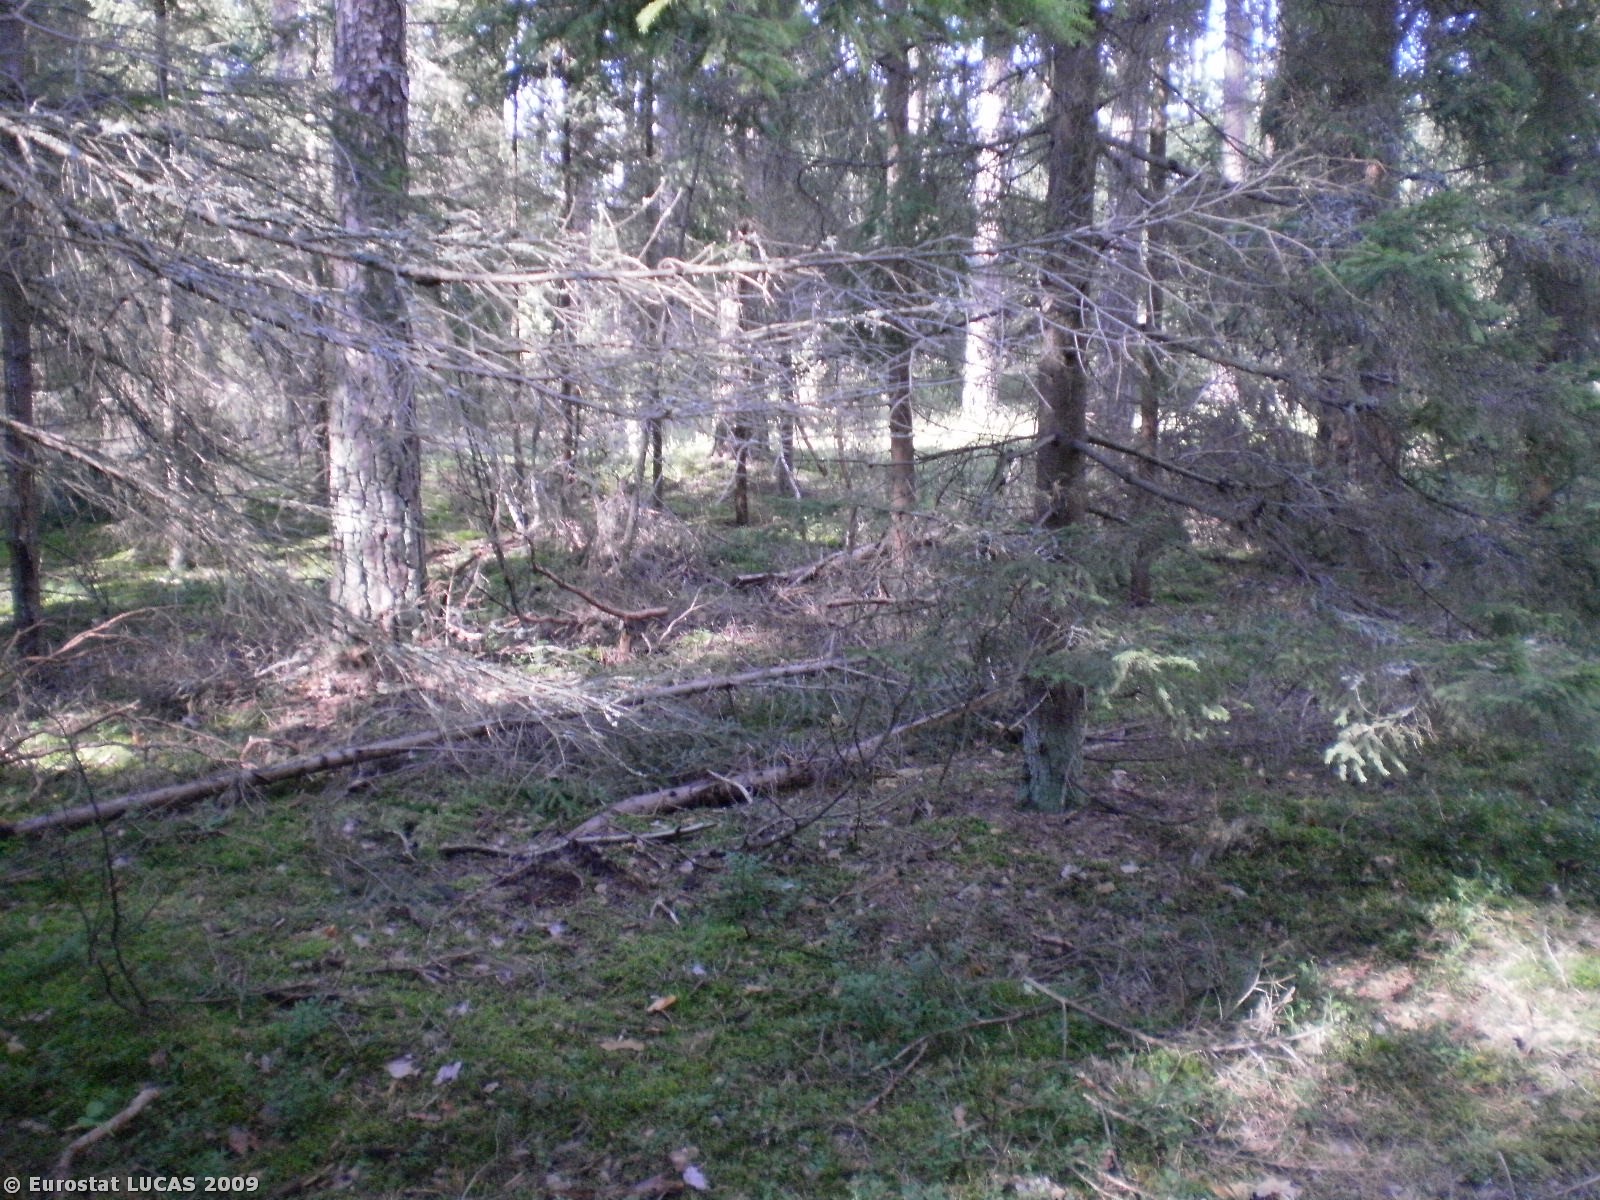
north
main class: Woodland
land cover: Coniferous woodland
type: hemiboreal forest and nemoral coniferous forest and mixed broadleaved-coniferous forest
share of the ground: 50 - 75 %
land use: Forestry
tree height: > 5 m
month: August
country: PL
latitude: 52.7730
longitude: 21.7496
